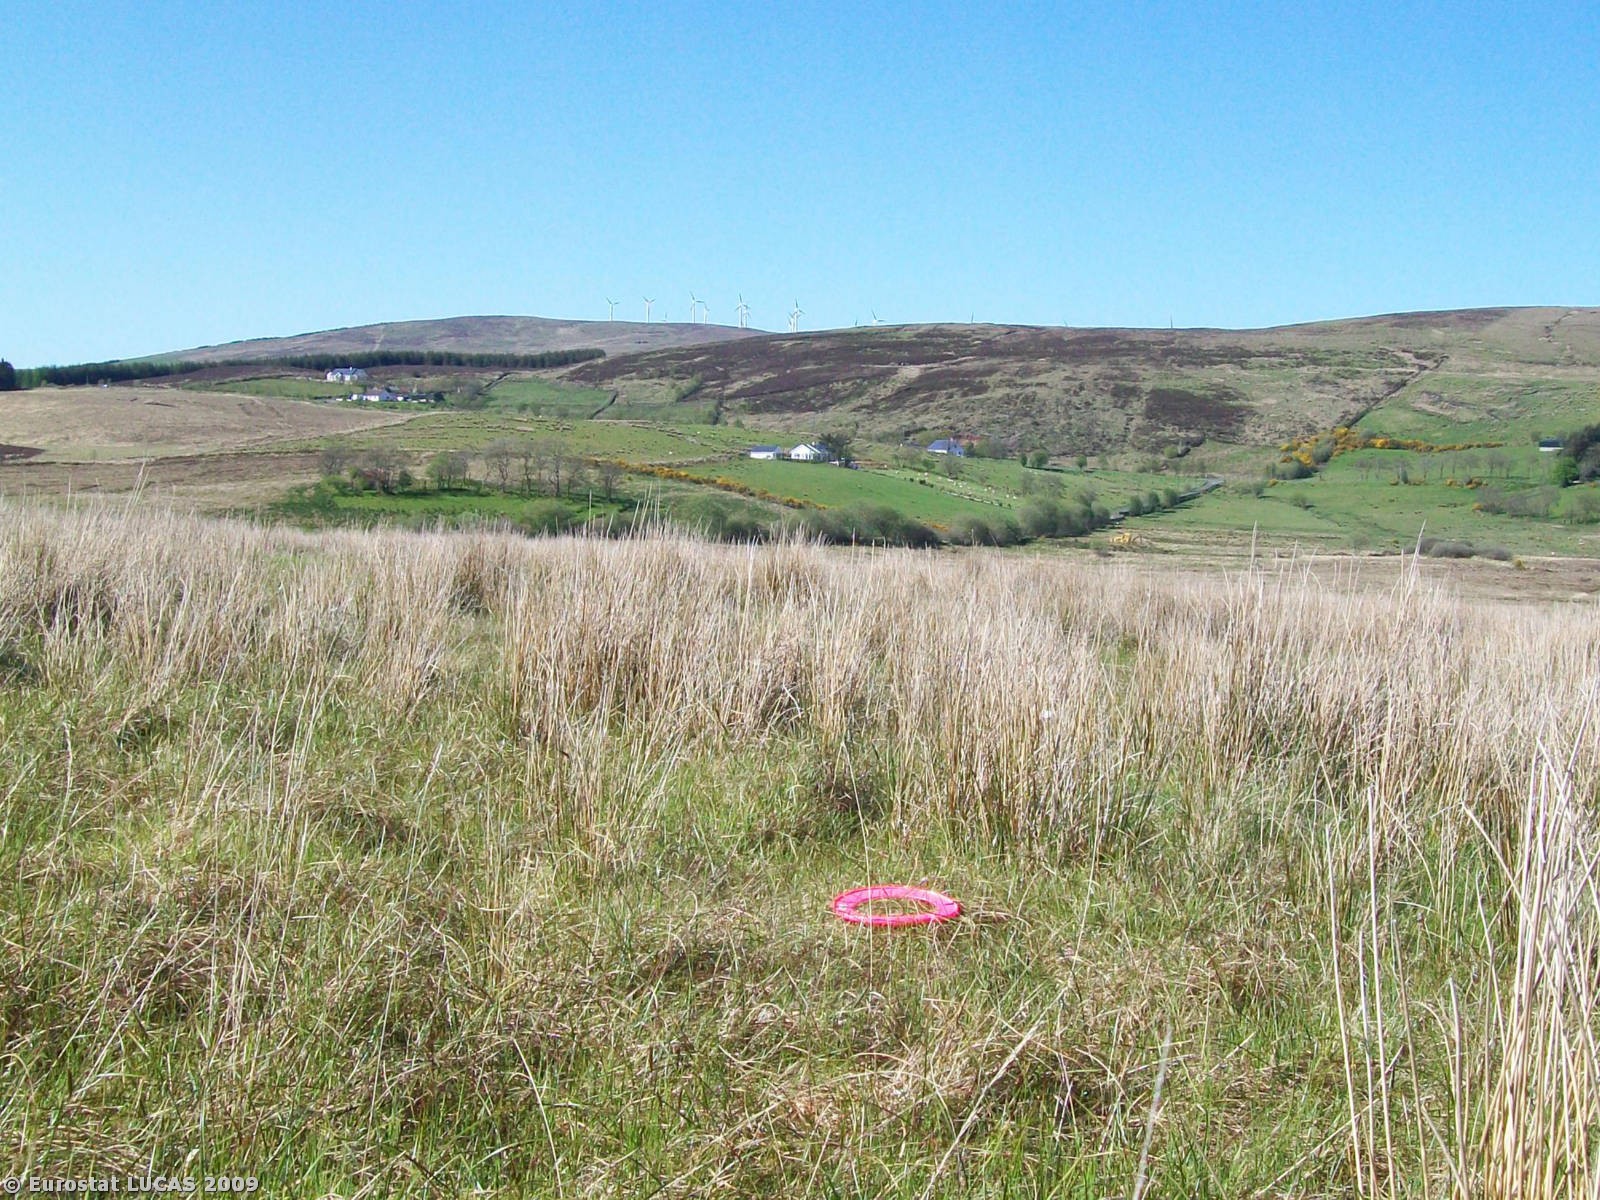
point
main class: Grassland
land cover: Grassland without tree/shrub cover
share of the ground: > 75 %
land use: Agriculture (excluding fallow land and kitchen gardens)
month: May
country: GB
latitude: 54.7736
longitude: -7.3269
